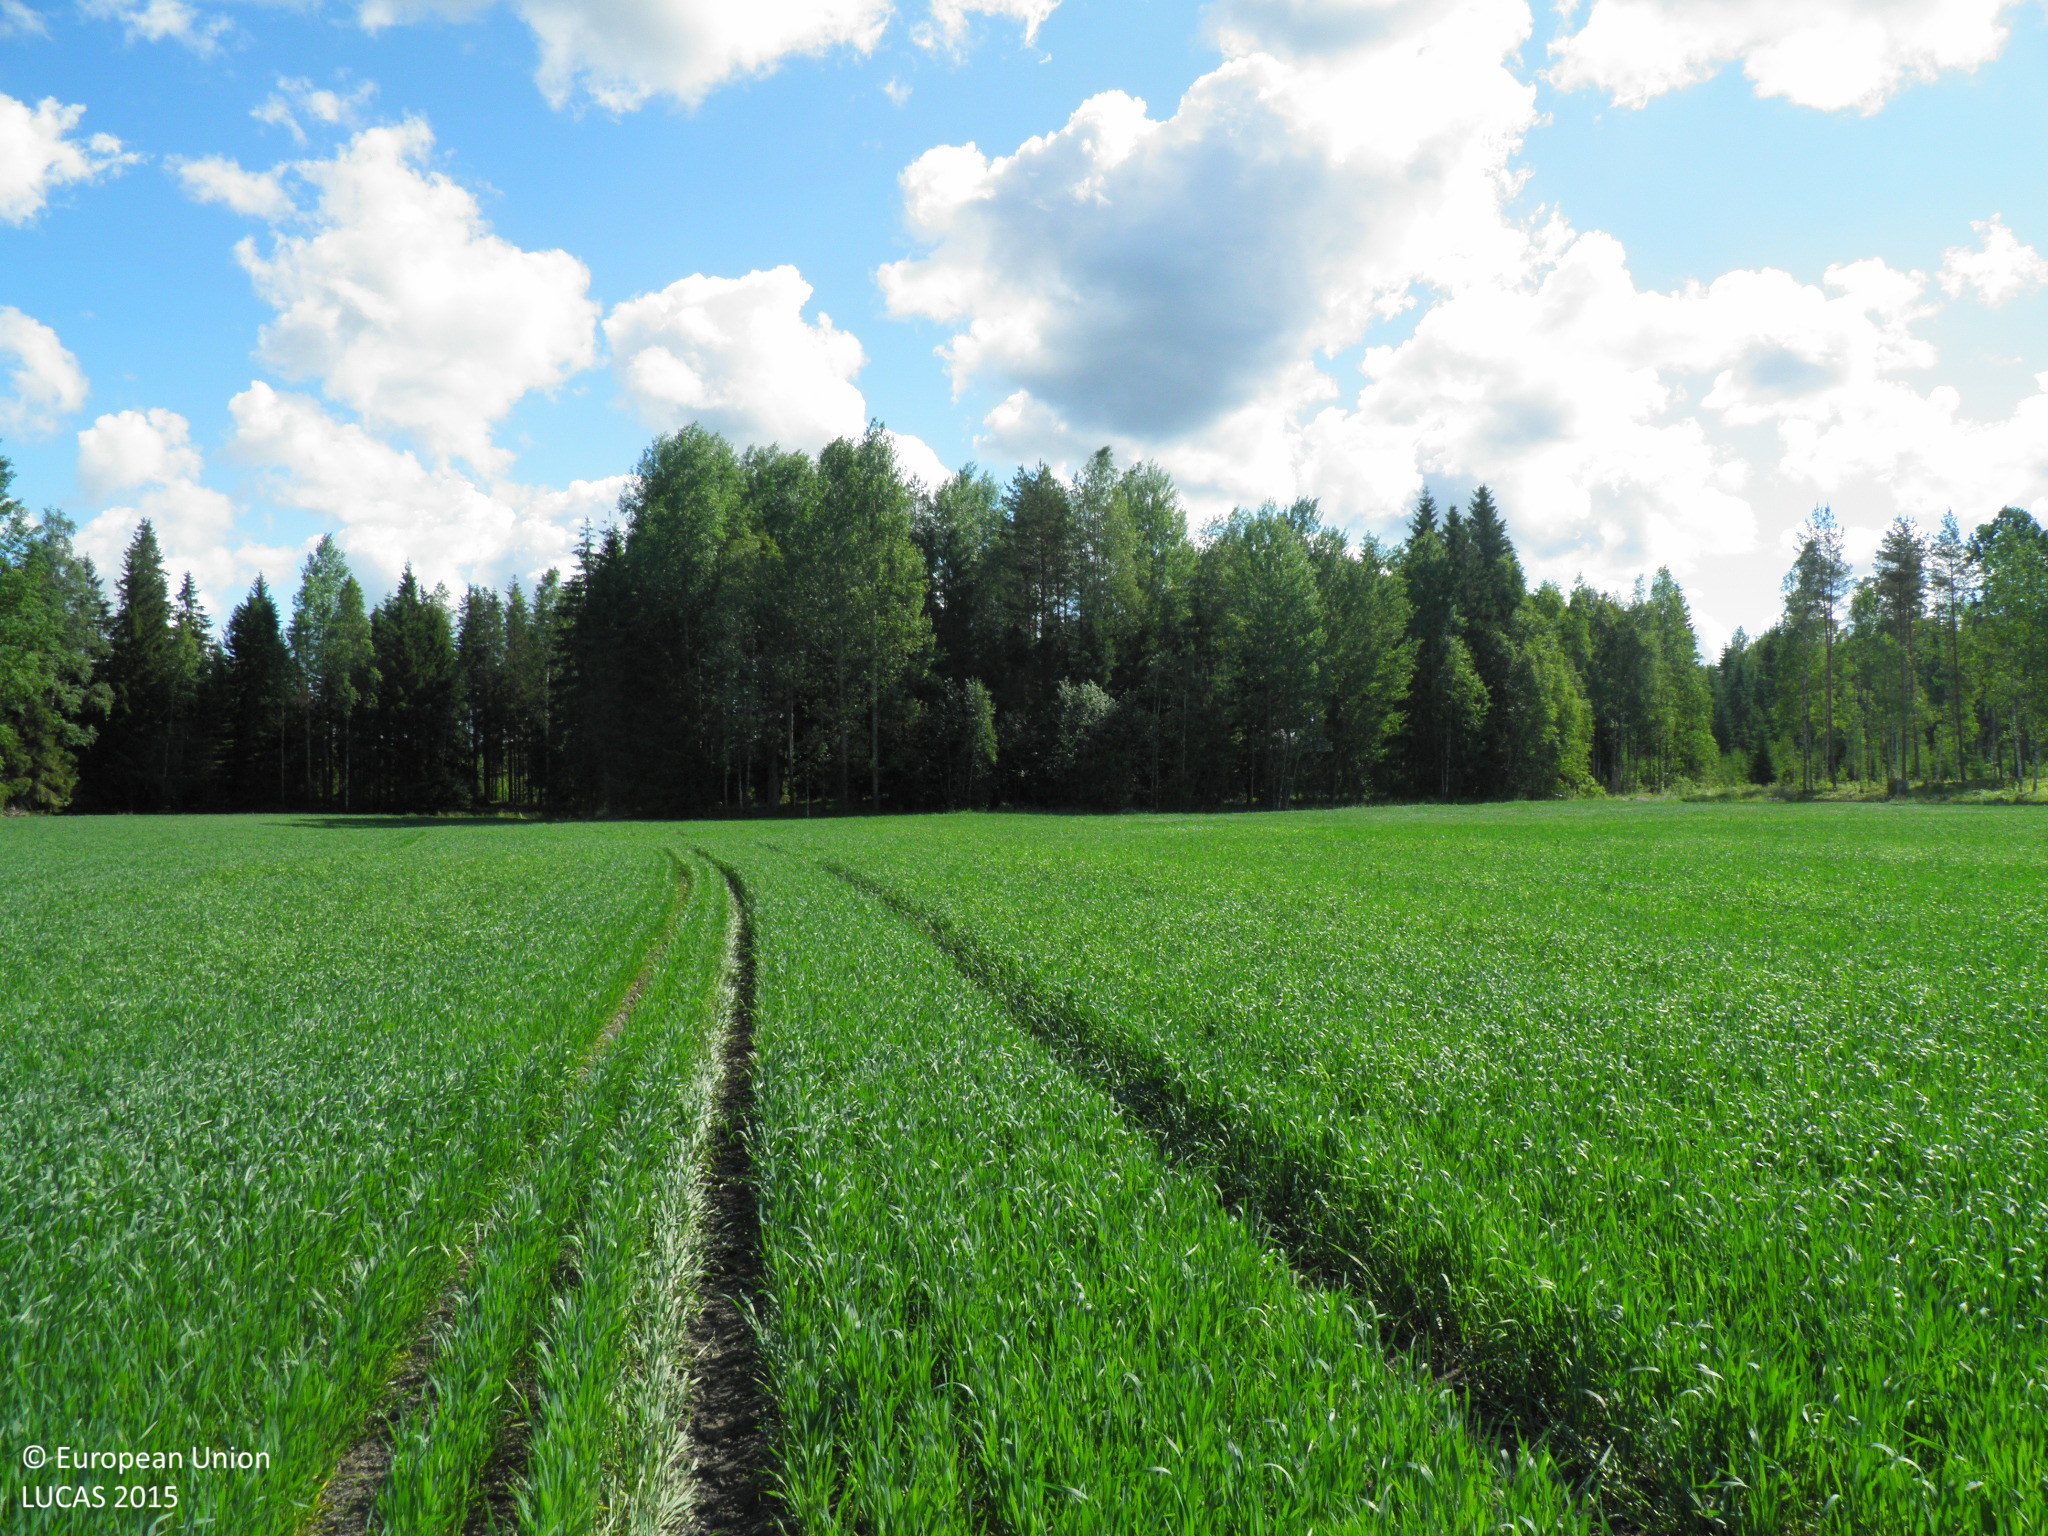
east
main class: Cropland
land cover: Common wheat
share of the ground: > 75 %
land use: Agriculture (excluding fallow land and kitchen gardens)
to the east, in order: Common wheat; Ditches and canals; Spruce dominated mixed woodland; Artificial constructions in urban areas; Spruce dominated mixed woodland; Ditches and canals; Spruce dominated mixed woodland
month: July
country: FI
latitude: 60.5334
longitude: 22.9247
